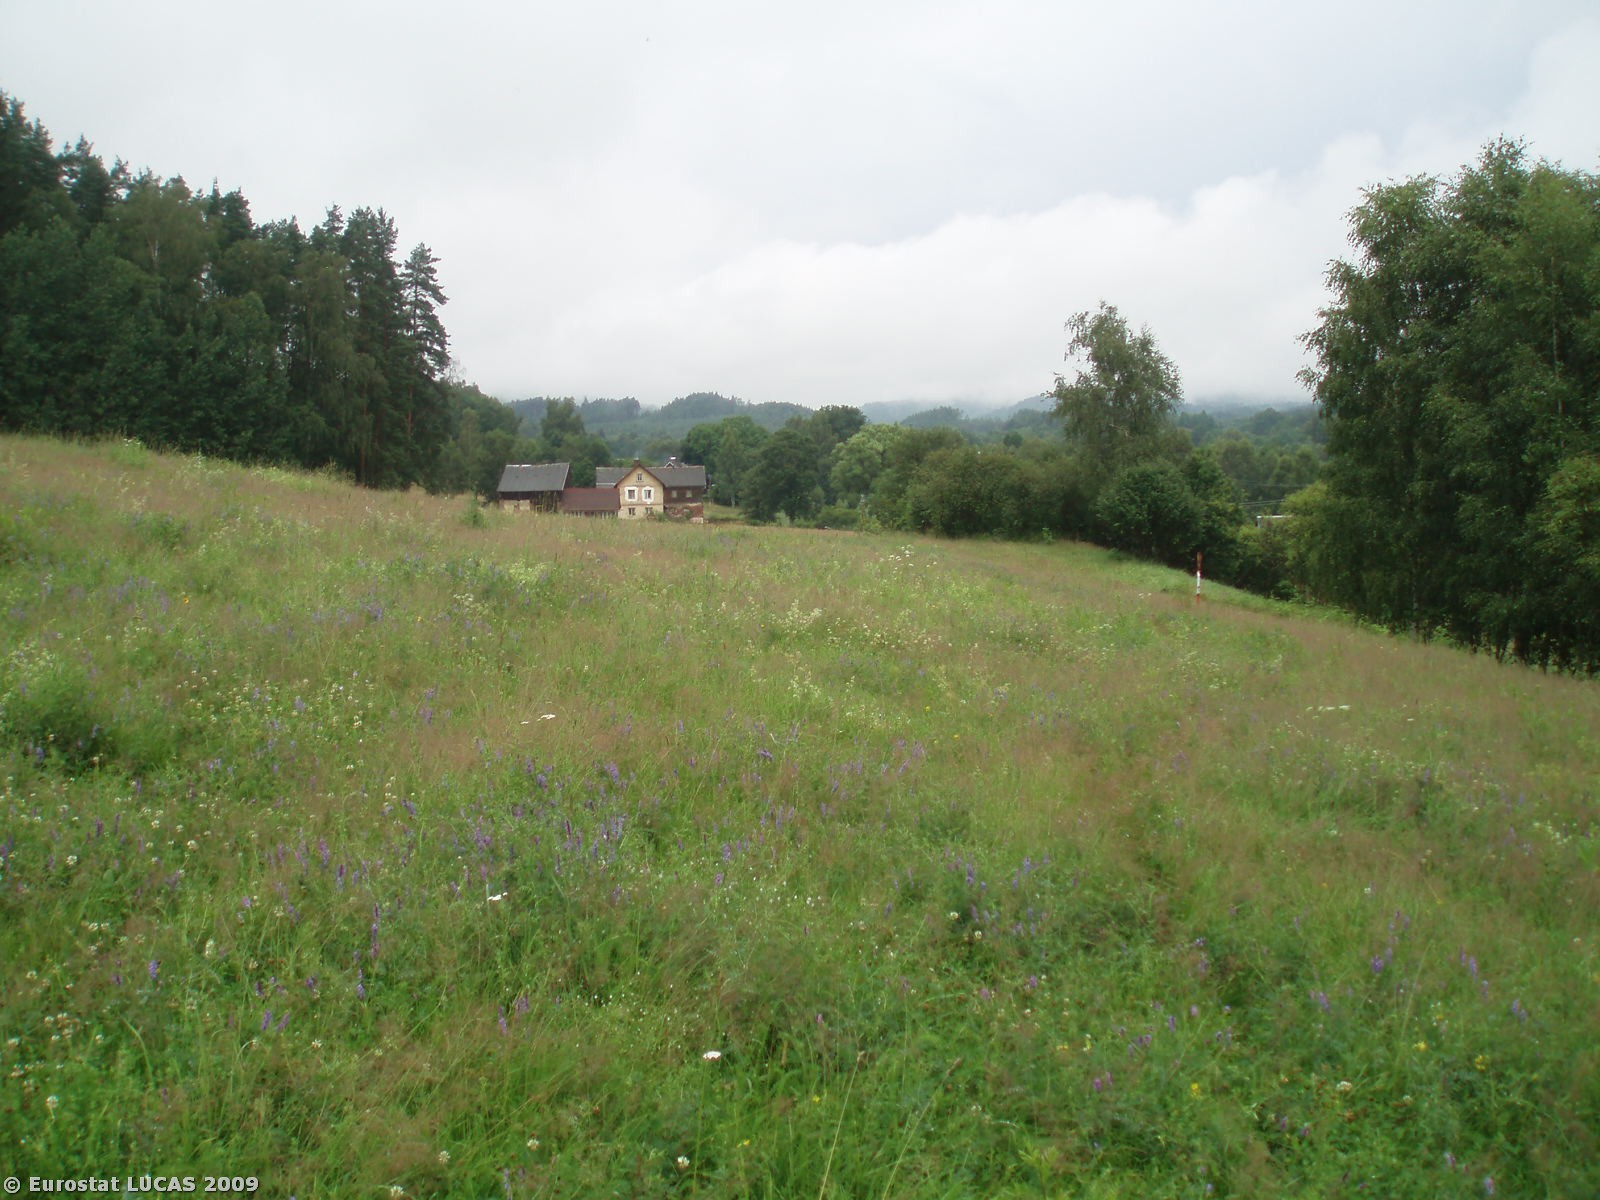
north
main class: Grassland
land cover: Grassland without tree/shrub cover
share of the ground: > 75 %
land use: Agriculture (excluding fallow land and kitchen gardens)
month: July
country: CZ
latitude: 50.7911
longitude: 14.6693
